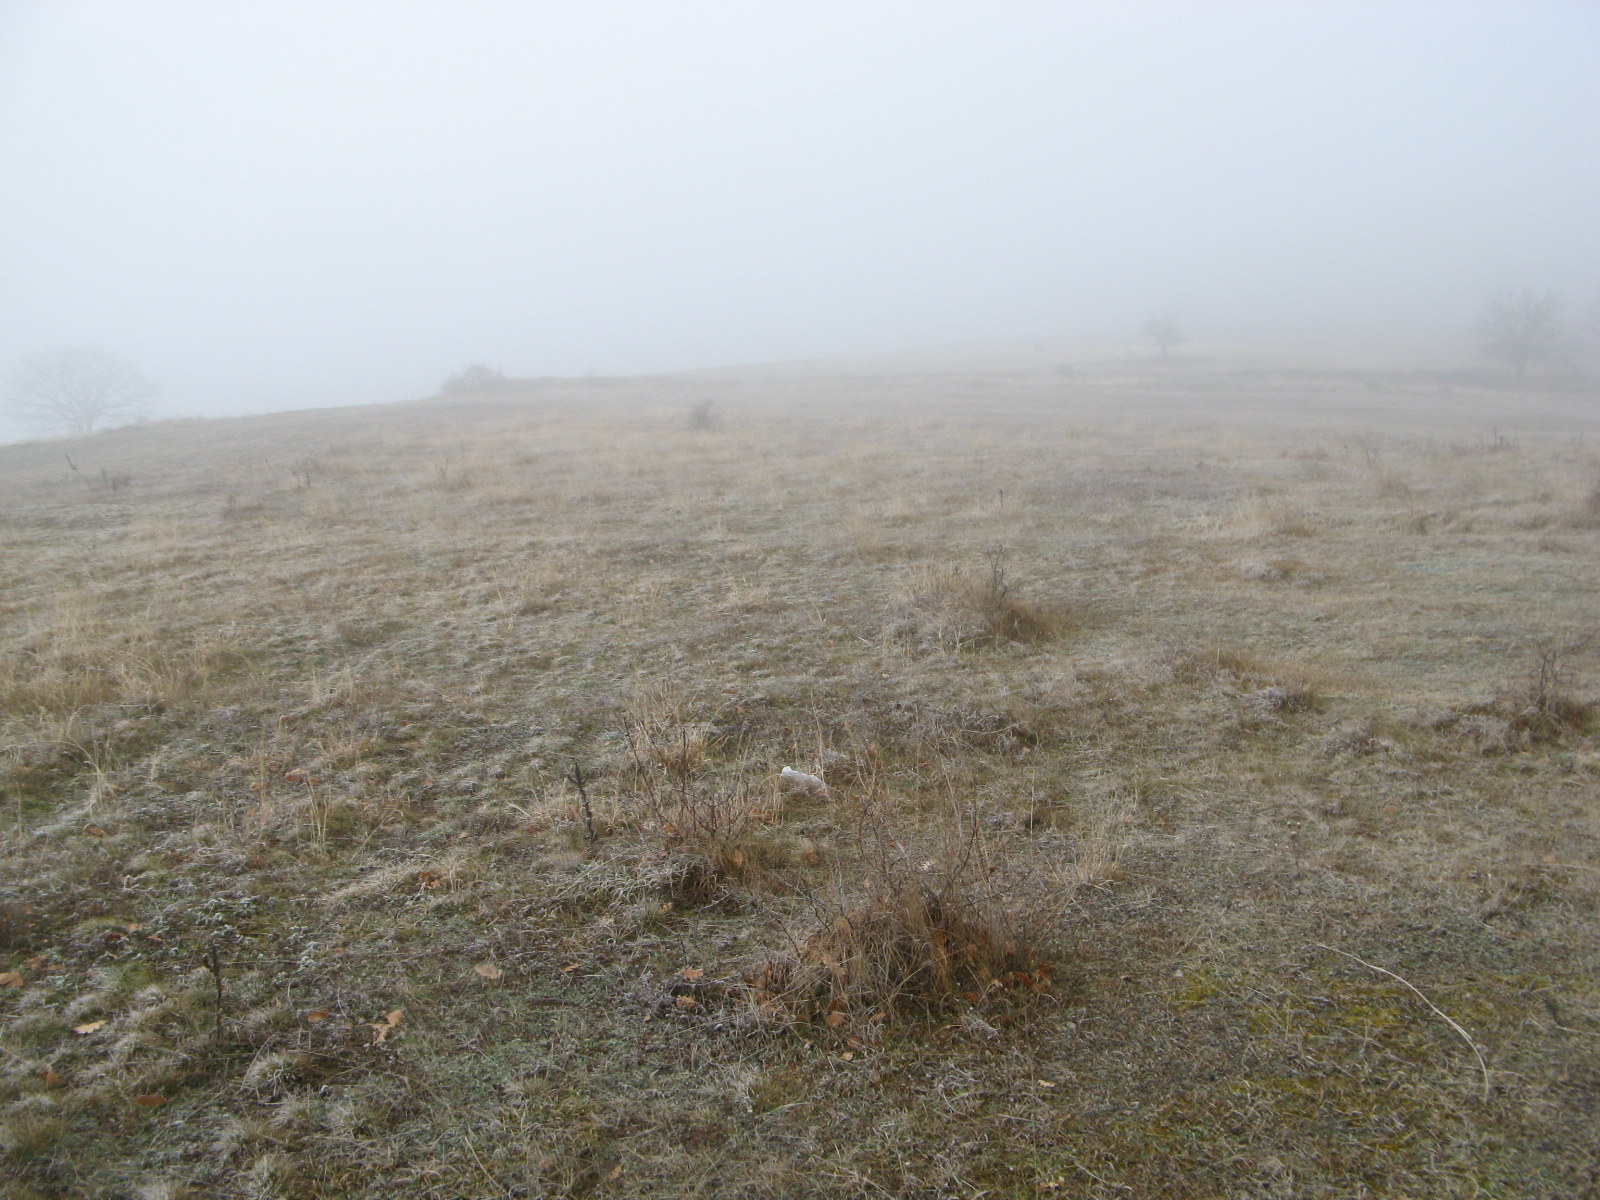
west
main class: Grassland
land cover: Grassland with sparse tree/shrub cover
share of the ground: > 75 %
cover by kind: herbaceous plants 90 %, broadleaved forest trees 5 %, shrubs 5 %
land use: Agriculture (excluding fallow land and kitchen gardens)
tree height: < 5 m
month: December
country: BG
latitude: 42.0622
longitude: 24.1183
